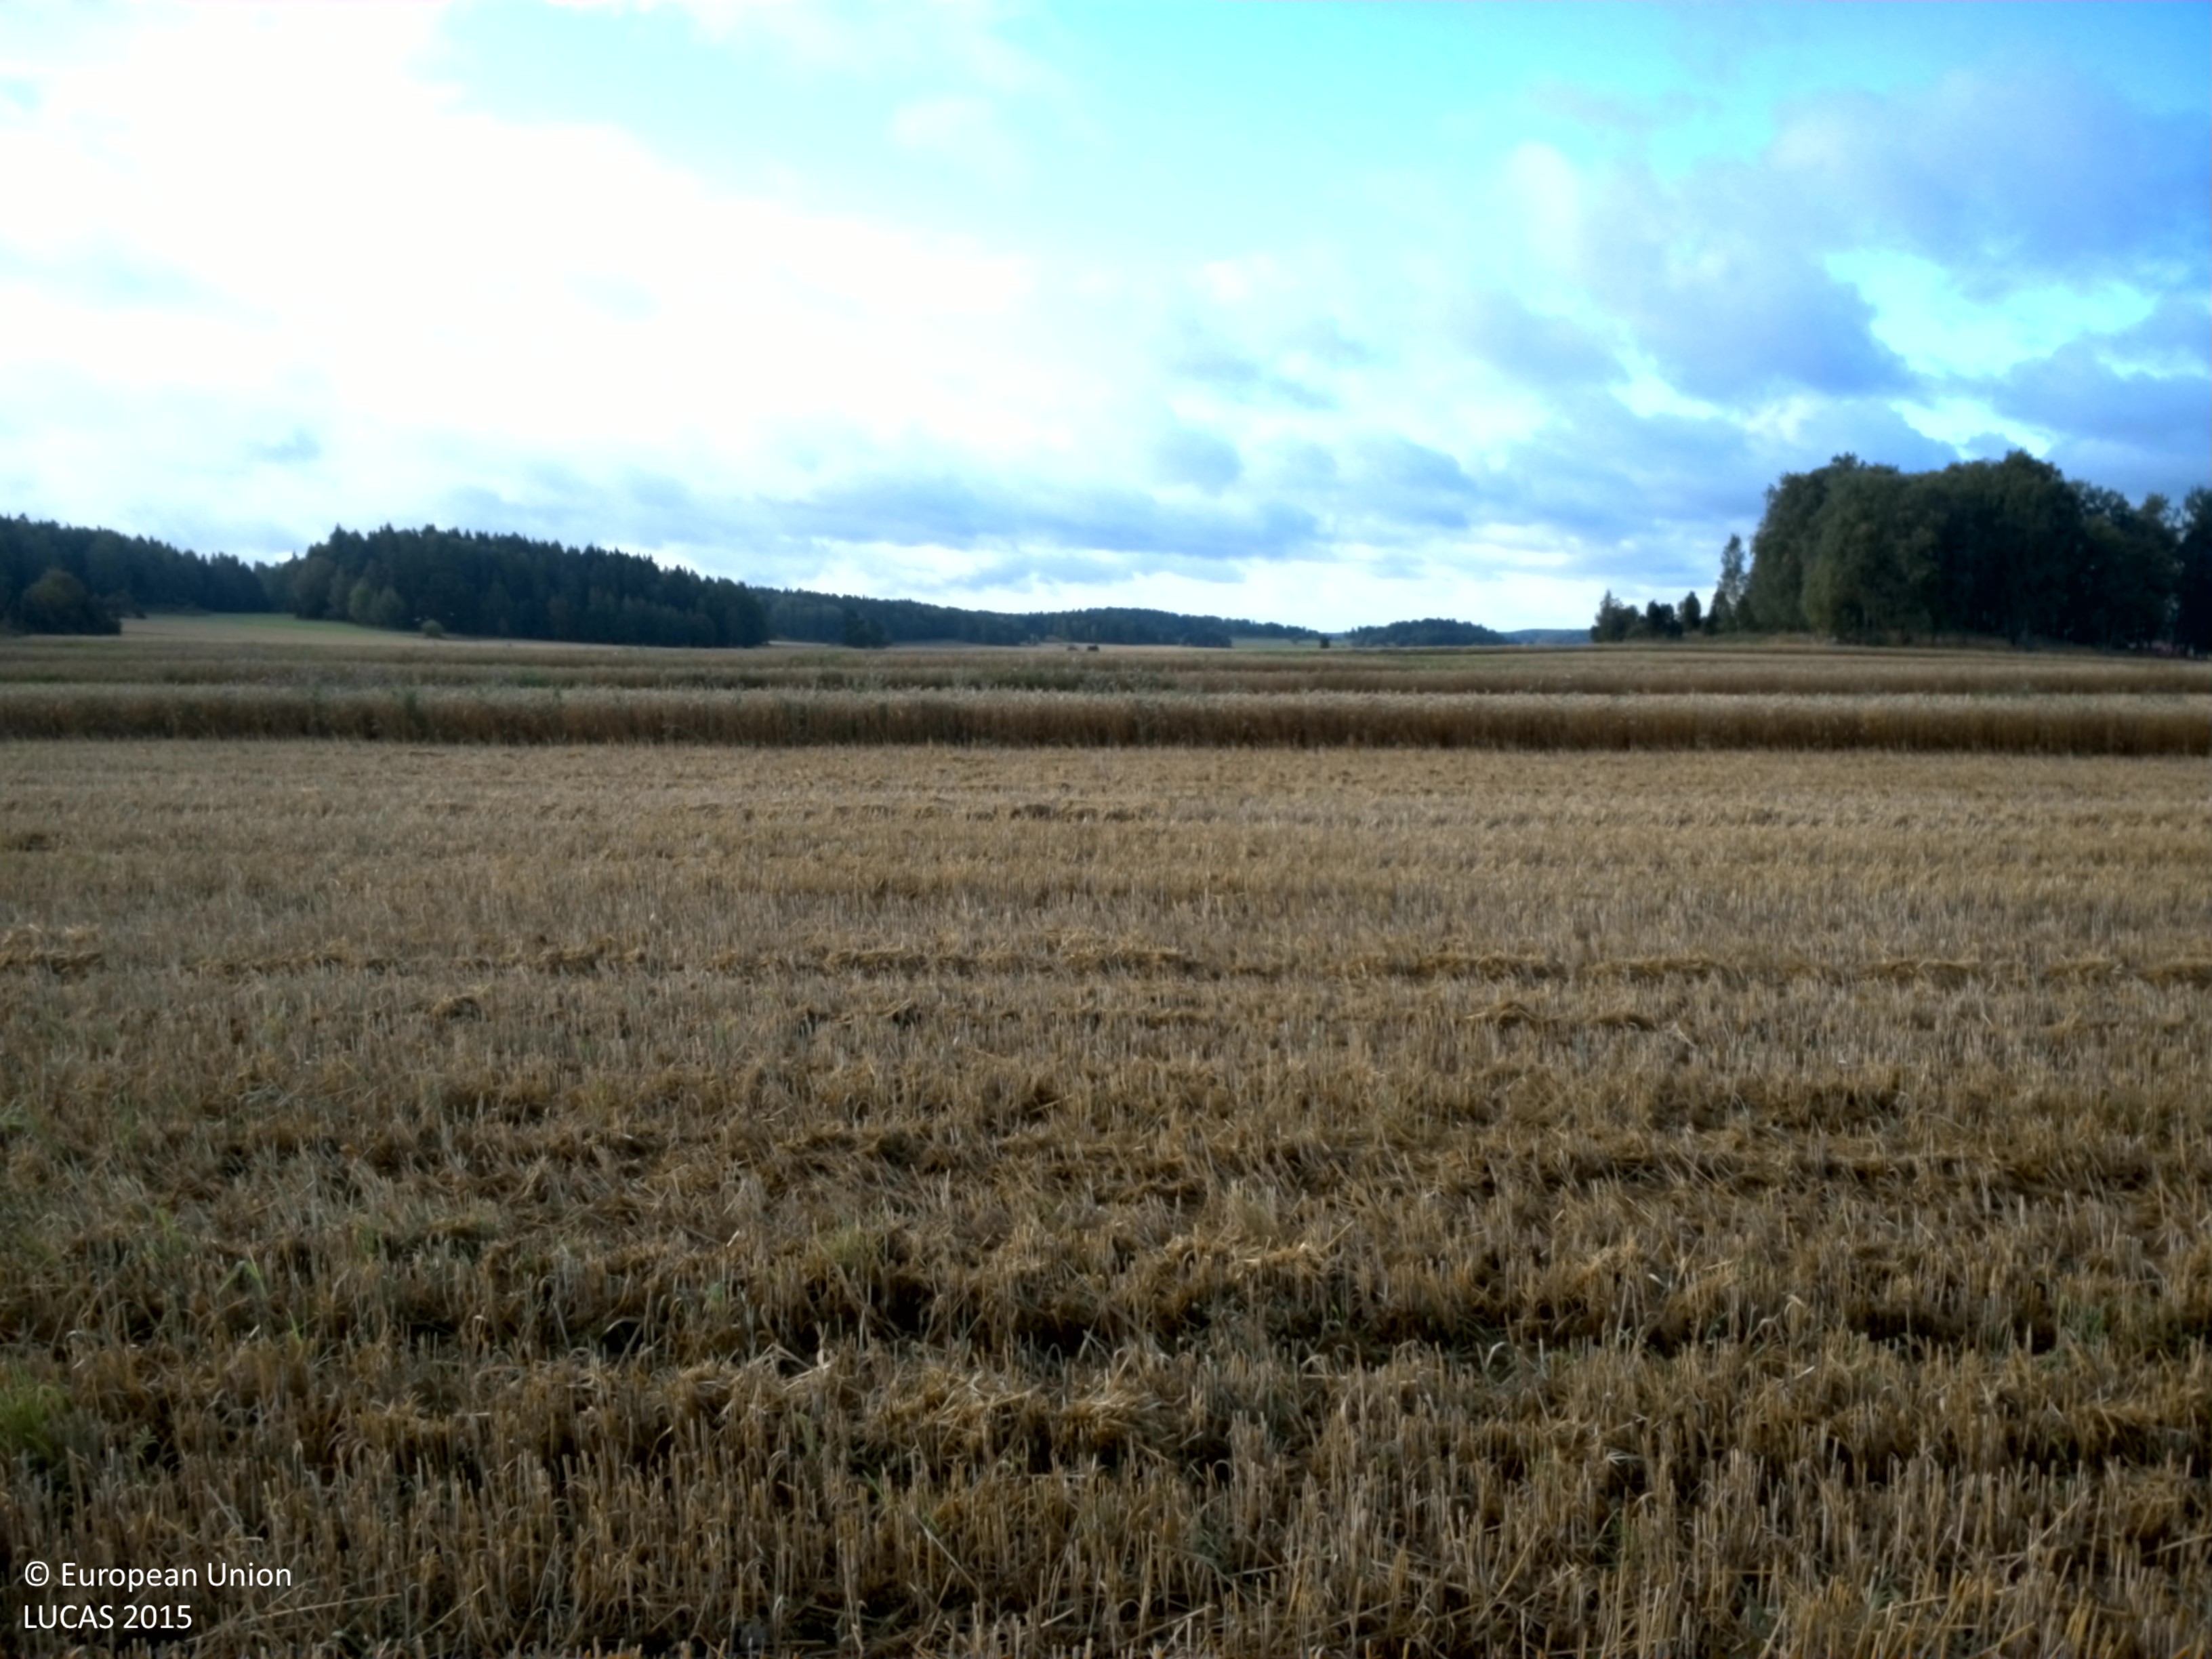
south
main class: Cropland
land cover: Common wheat
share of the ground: < 10 %
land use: Agriculture (excluding fallow land and kitchen gardens)
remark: Harvested field
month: August
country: SE
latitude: 59.7848
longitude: 17.1009
